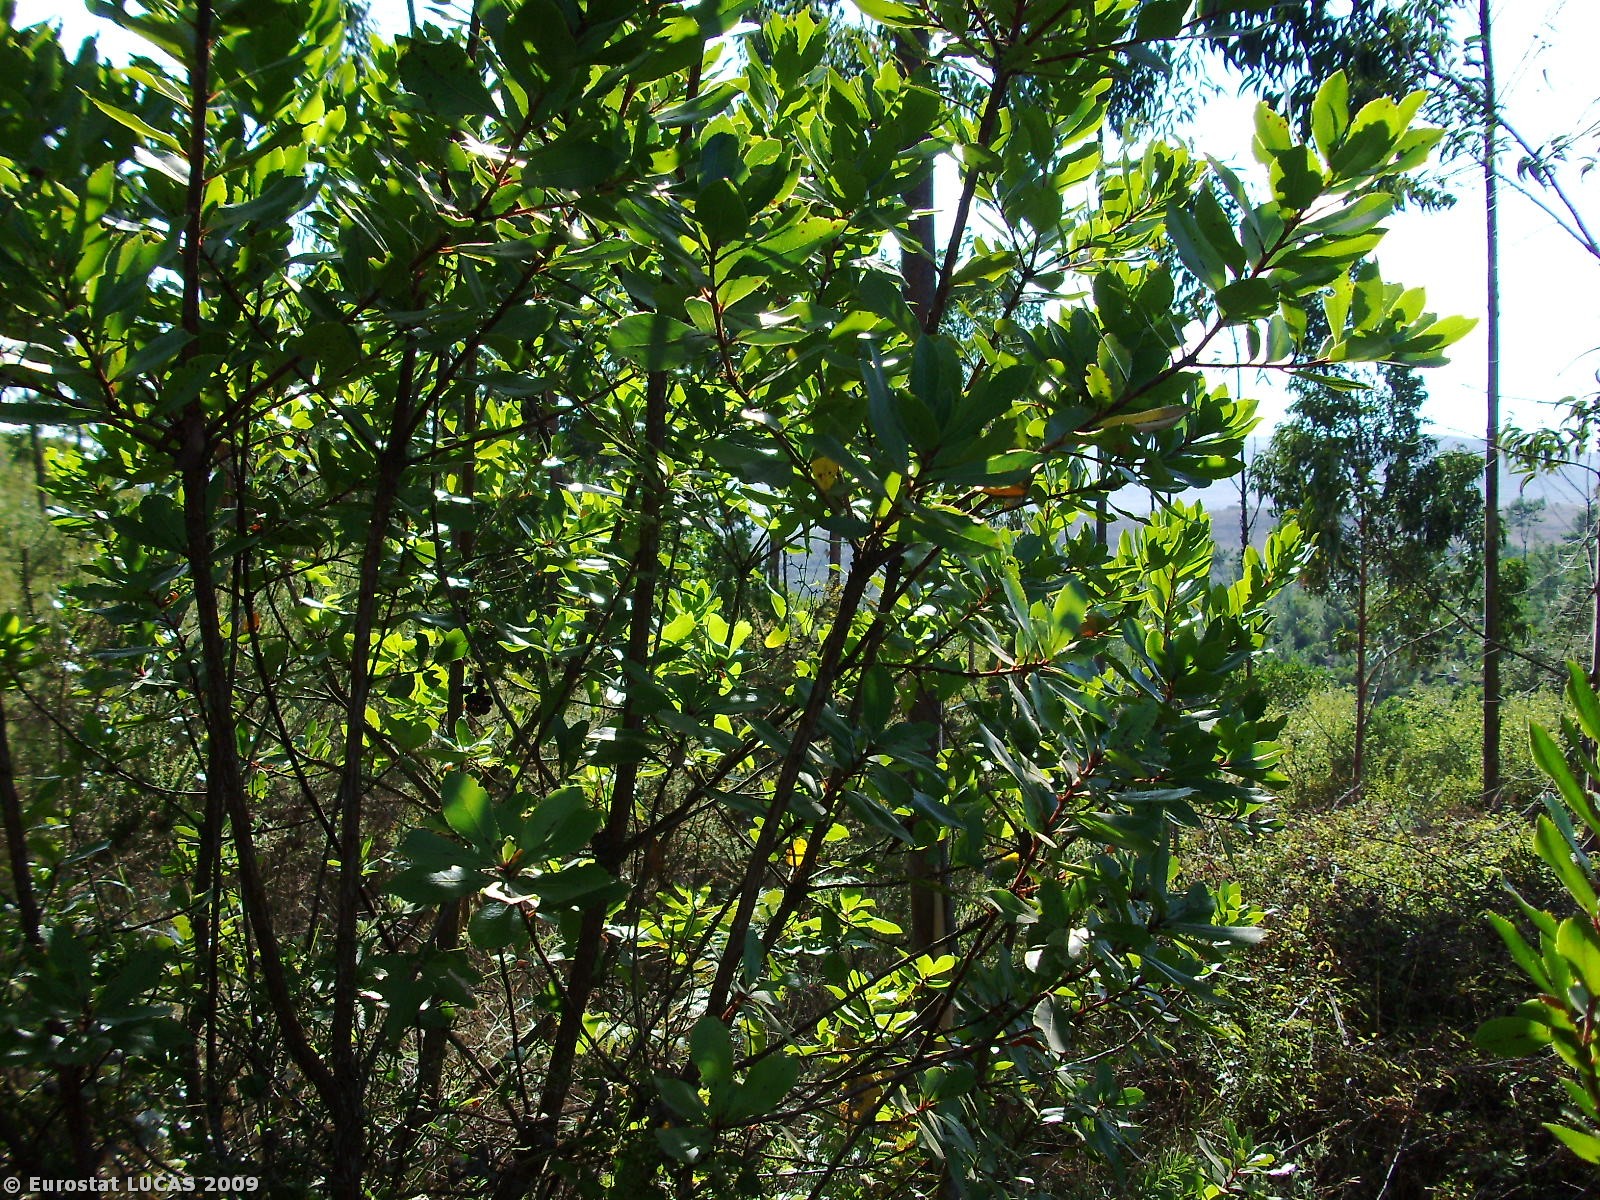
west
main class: Woodland
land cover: Broadleaved woodland
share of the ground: 25 - 50 %
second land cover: Shrubland with sparse tree cover
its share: 50 - 75 %
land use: Forestry
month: August
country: PT
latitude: 40.0409
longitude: -8.4226
